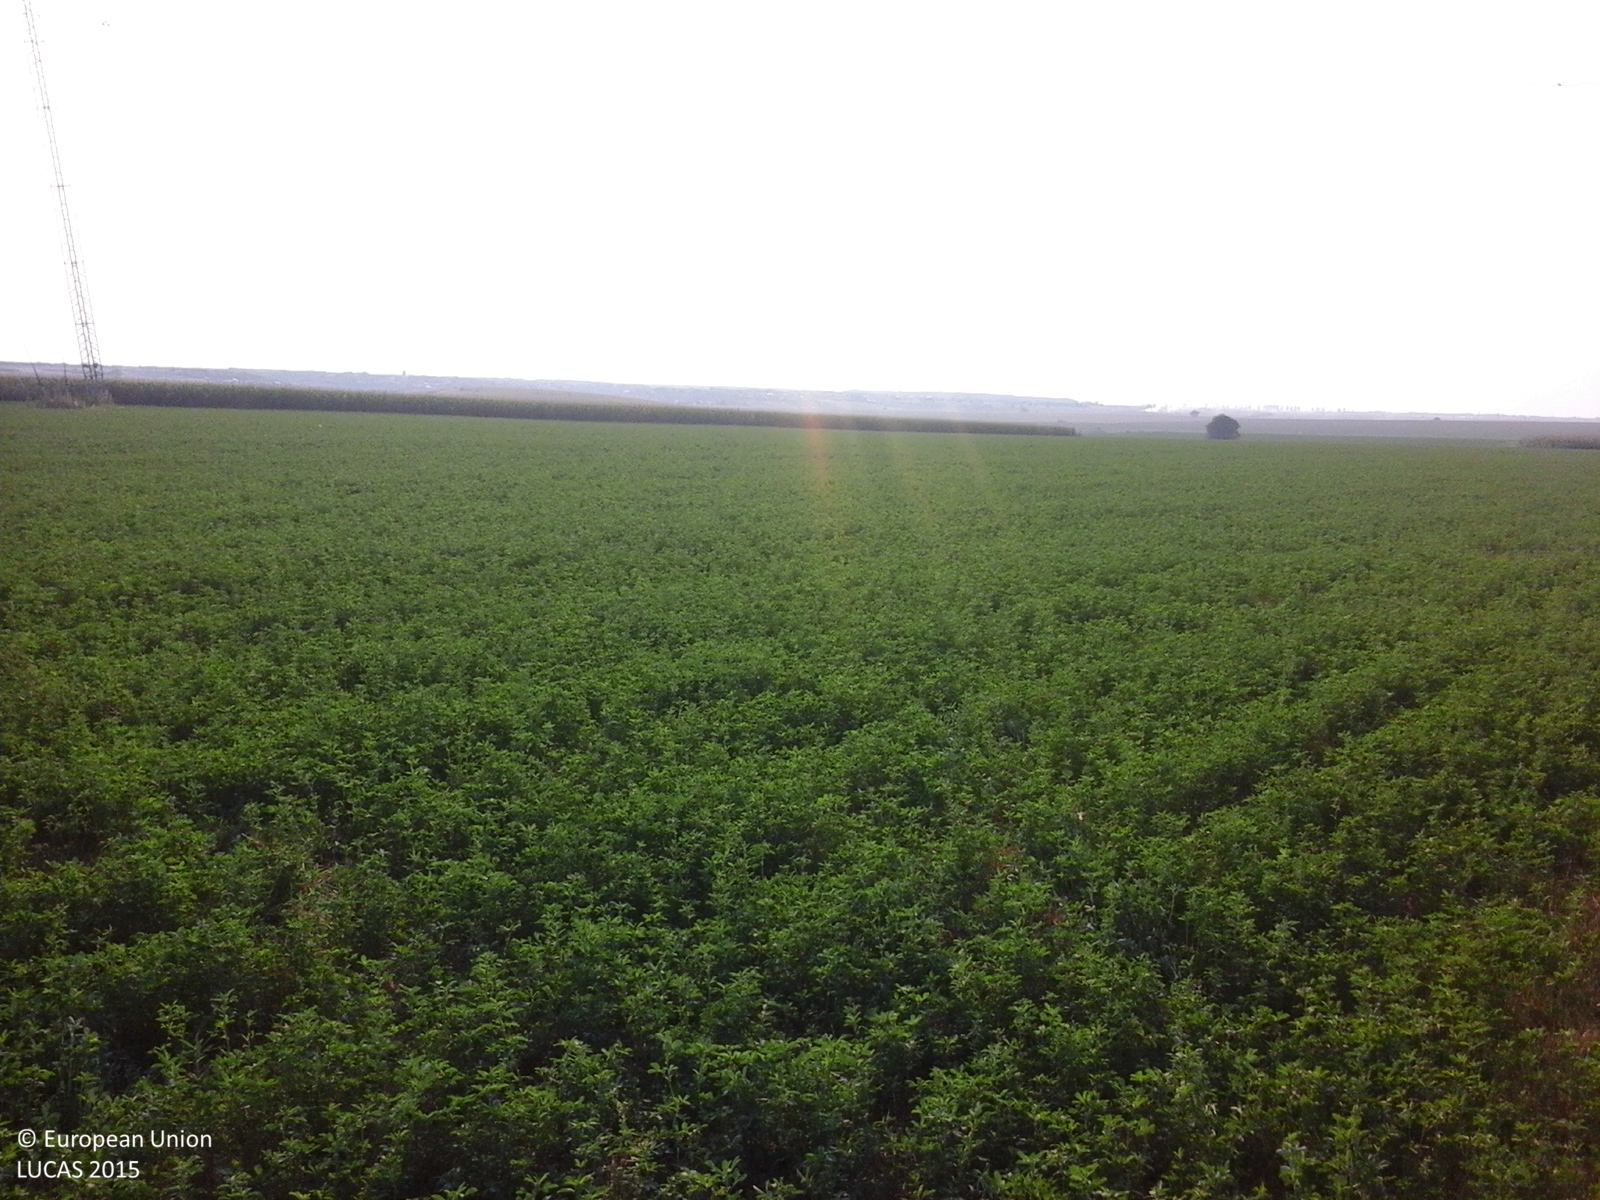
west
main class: Cropland
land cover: Lucerne
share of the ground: > 75 %
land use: Agriculture (excluding fallow land and kitchen gardens)
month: July
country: RO
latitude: 44.5024
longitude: 26.5301
